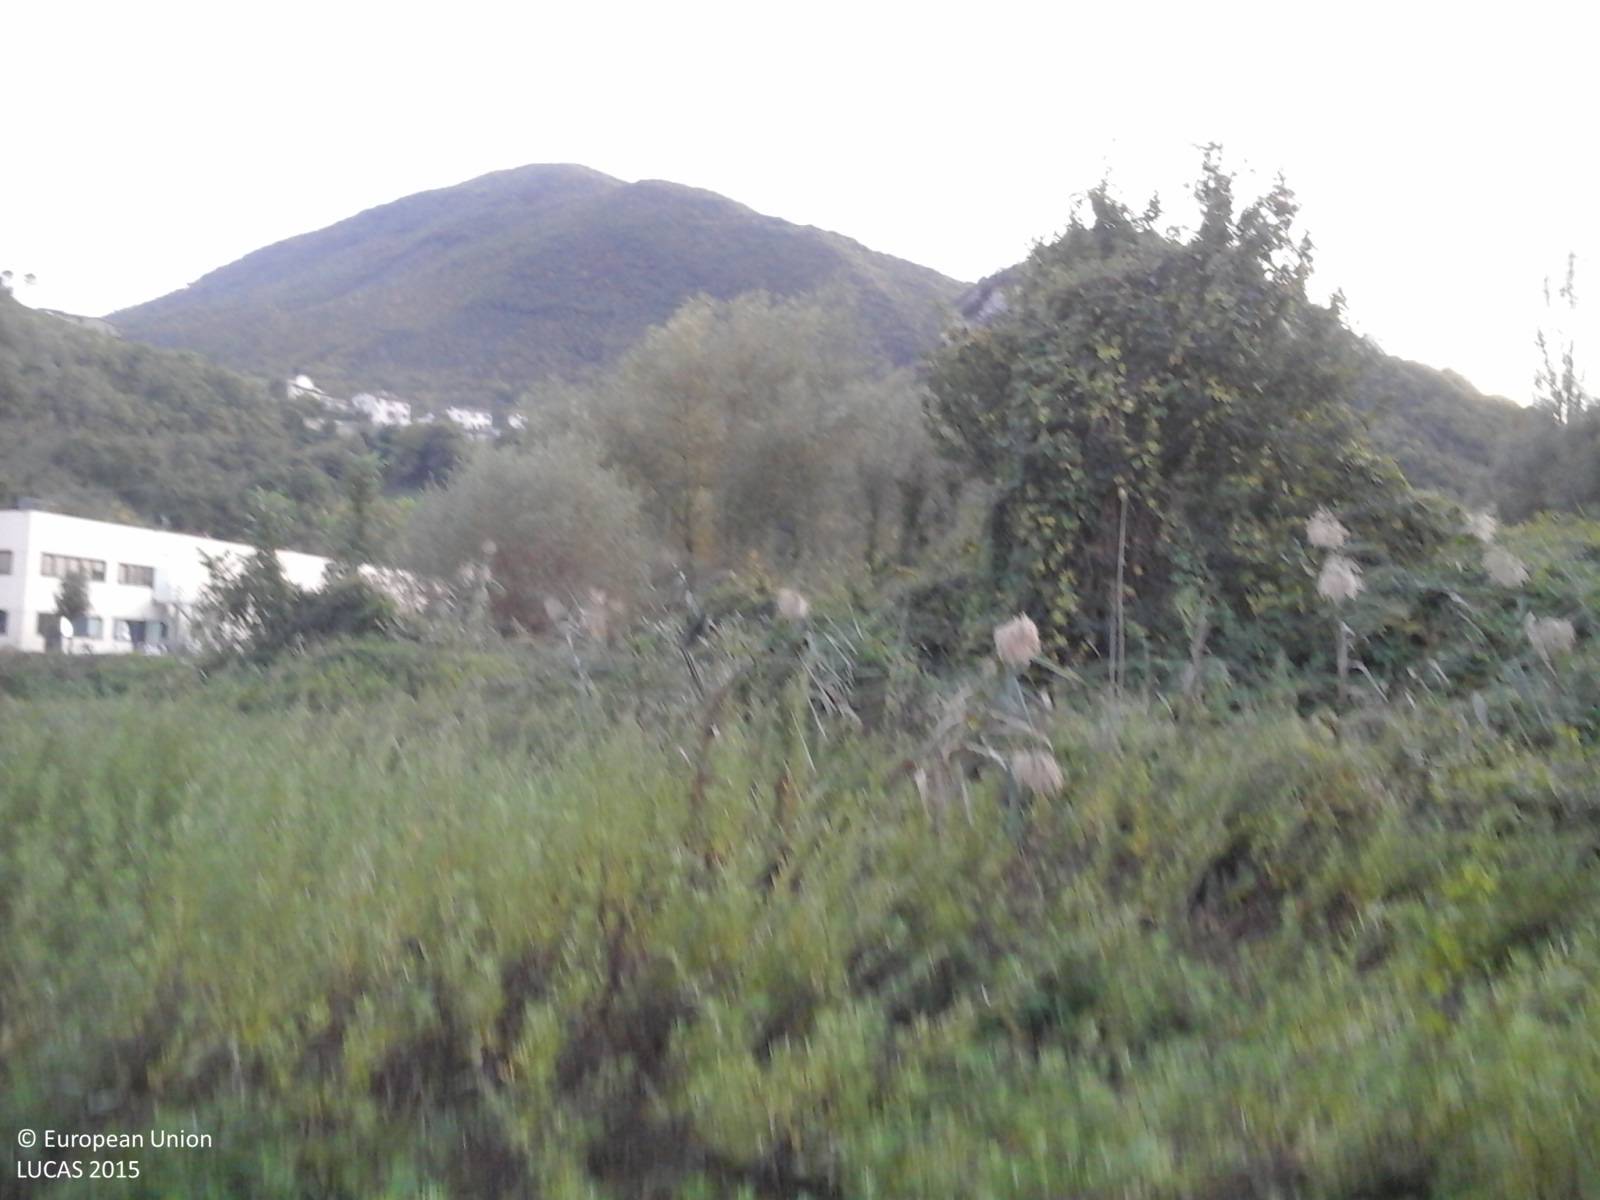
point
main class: Shrubland
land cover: Shrubland with sparse tree cover
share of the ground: 50 - 75 %
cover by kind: shrubs 70 %, herbaceous plants 25 %, broadleaved forest trees 5 %
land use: Abandoned areas
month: October
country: IT
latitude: 42.8109
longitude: 12.9140
